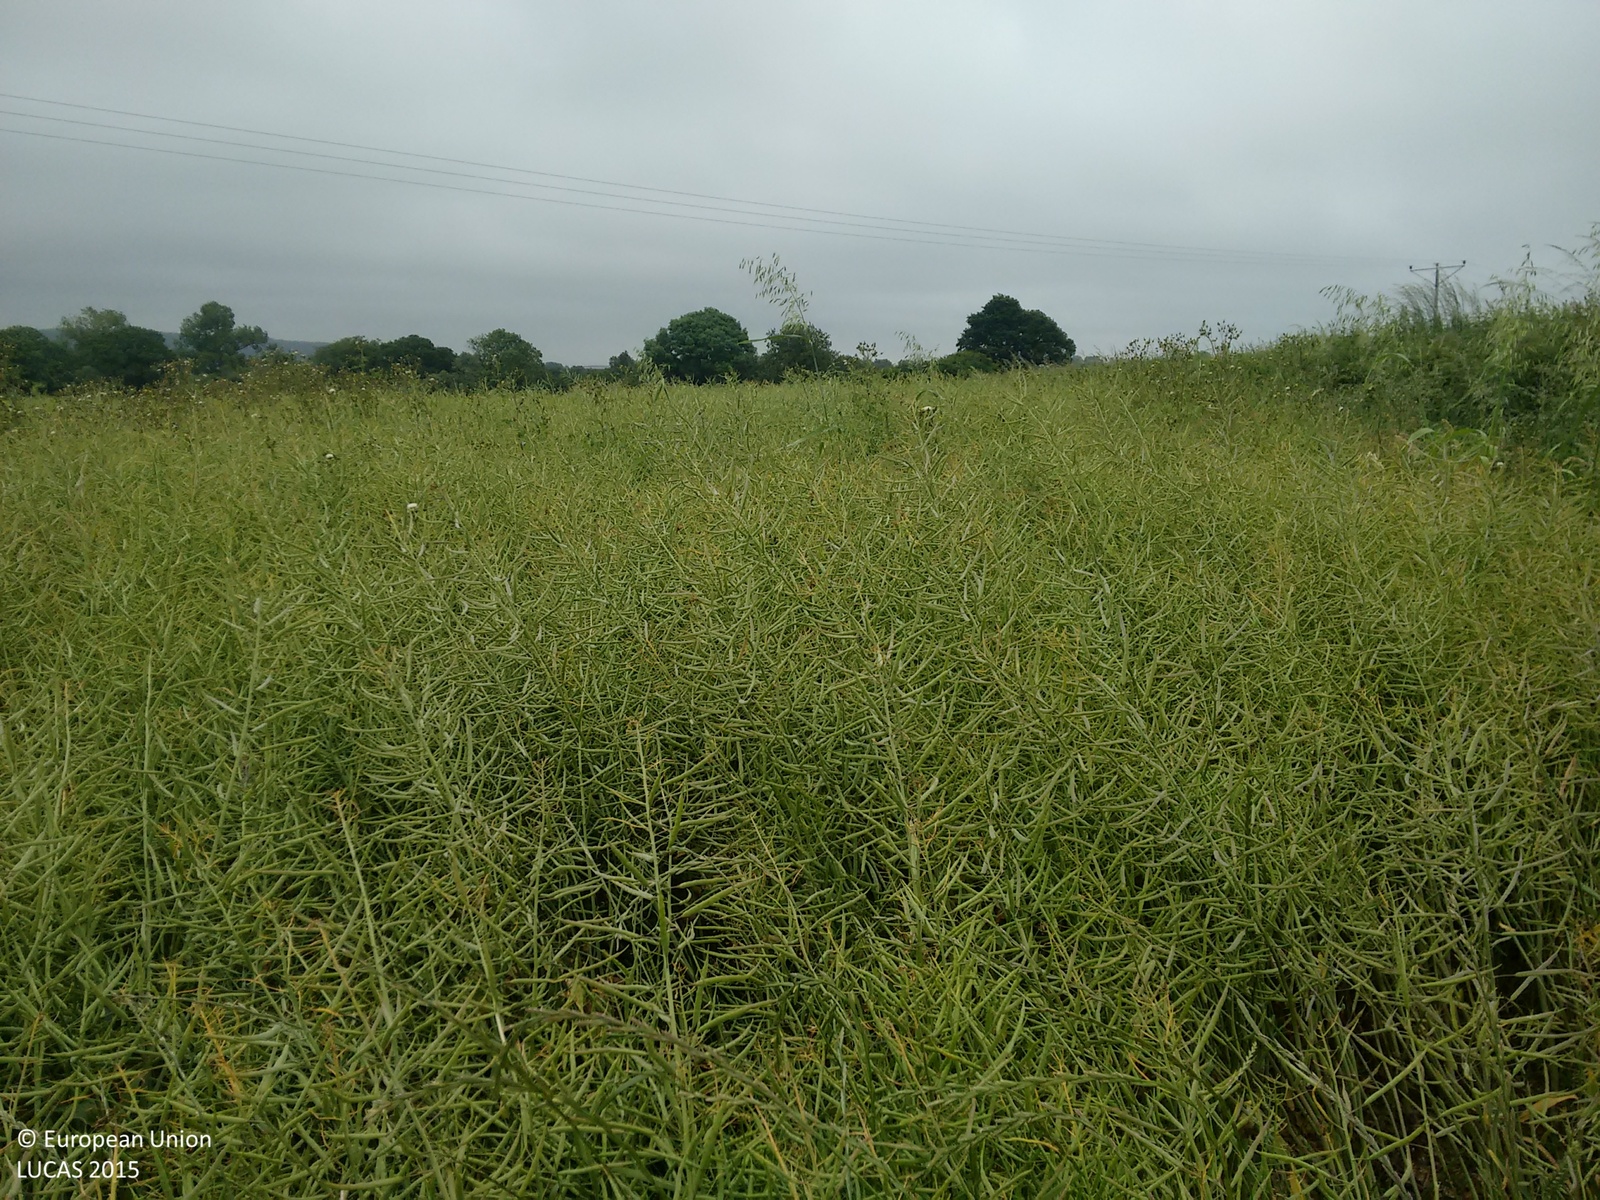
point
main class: Cropland
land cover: Dry pulses
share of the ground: > 75 %
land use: Agriculture (excluding fallow land and kitchen gardens)
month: June
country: IE
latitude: 52.4951
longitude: -7.2818
